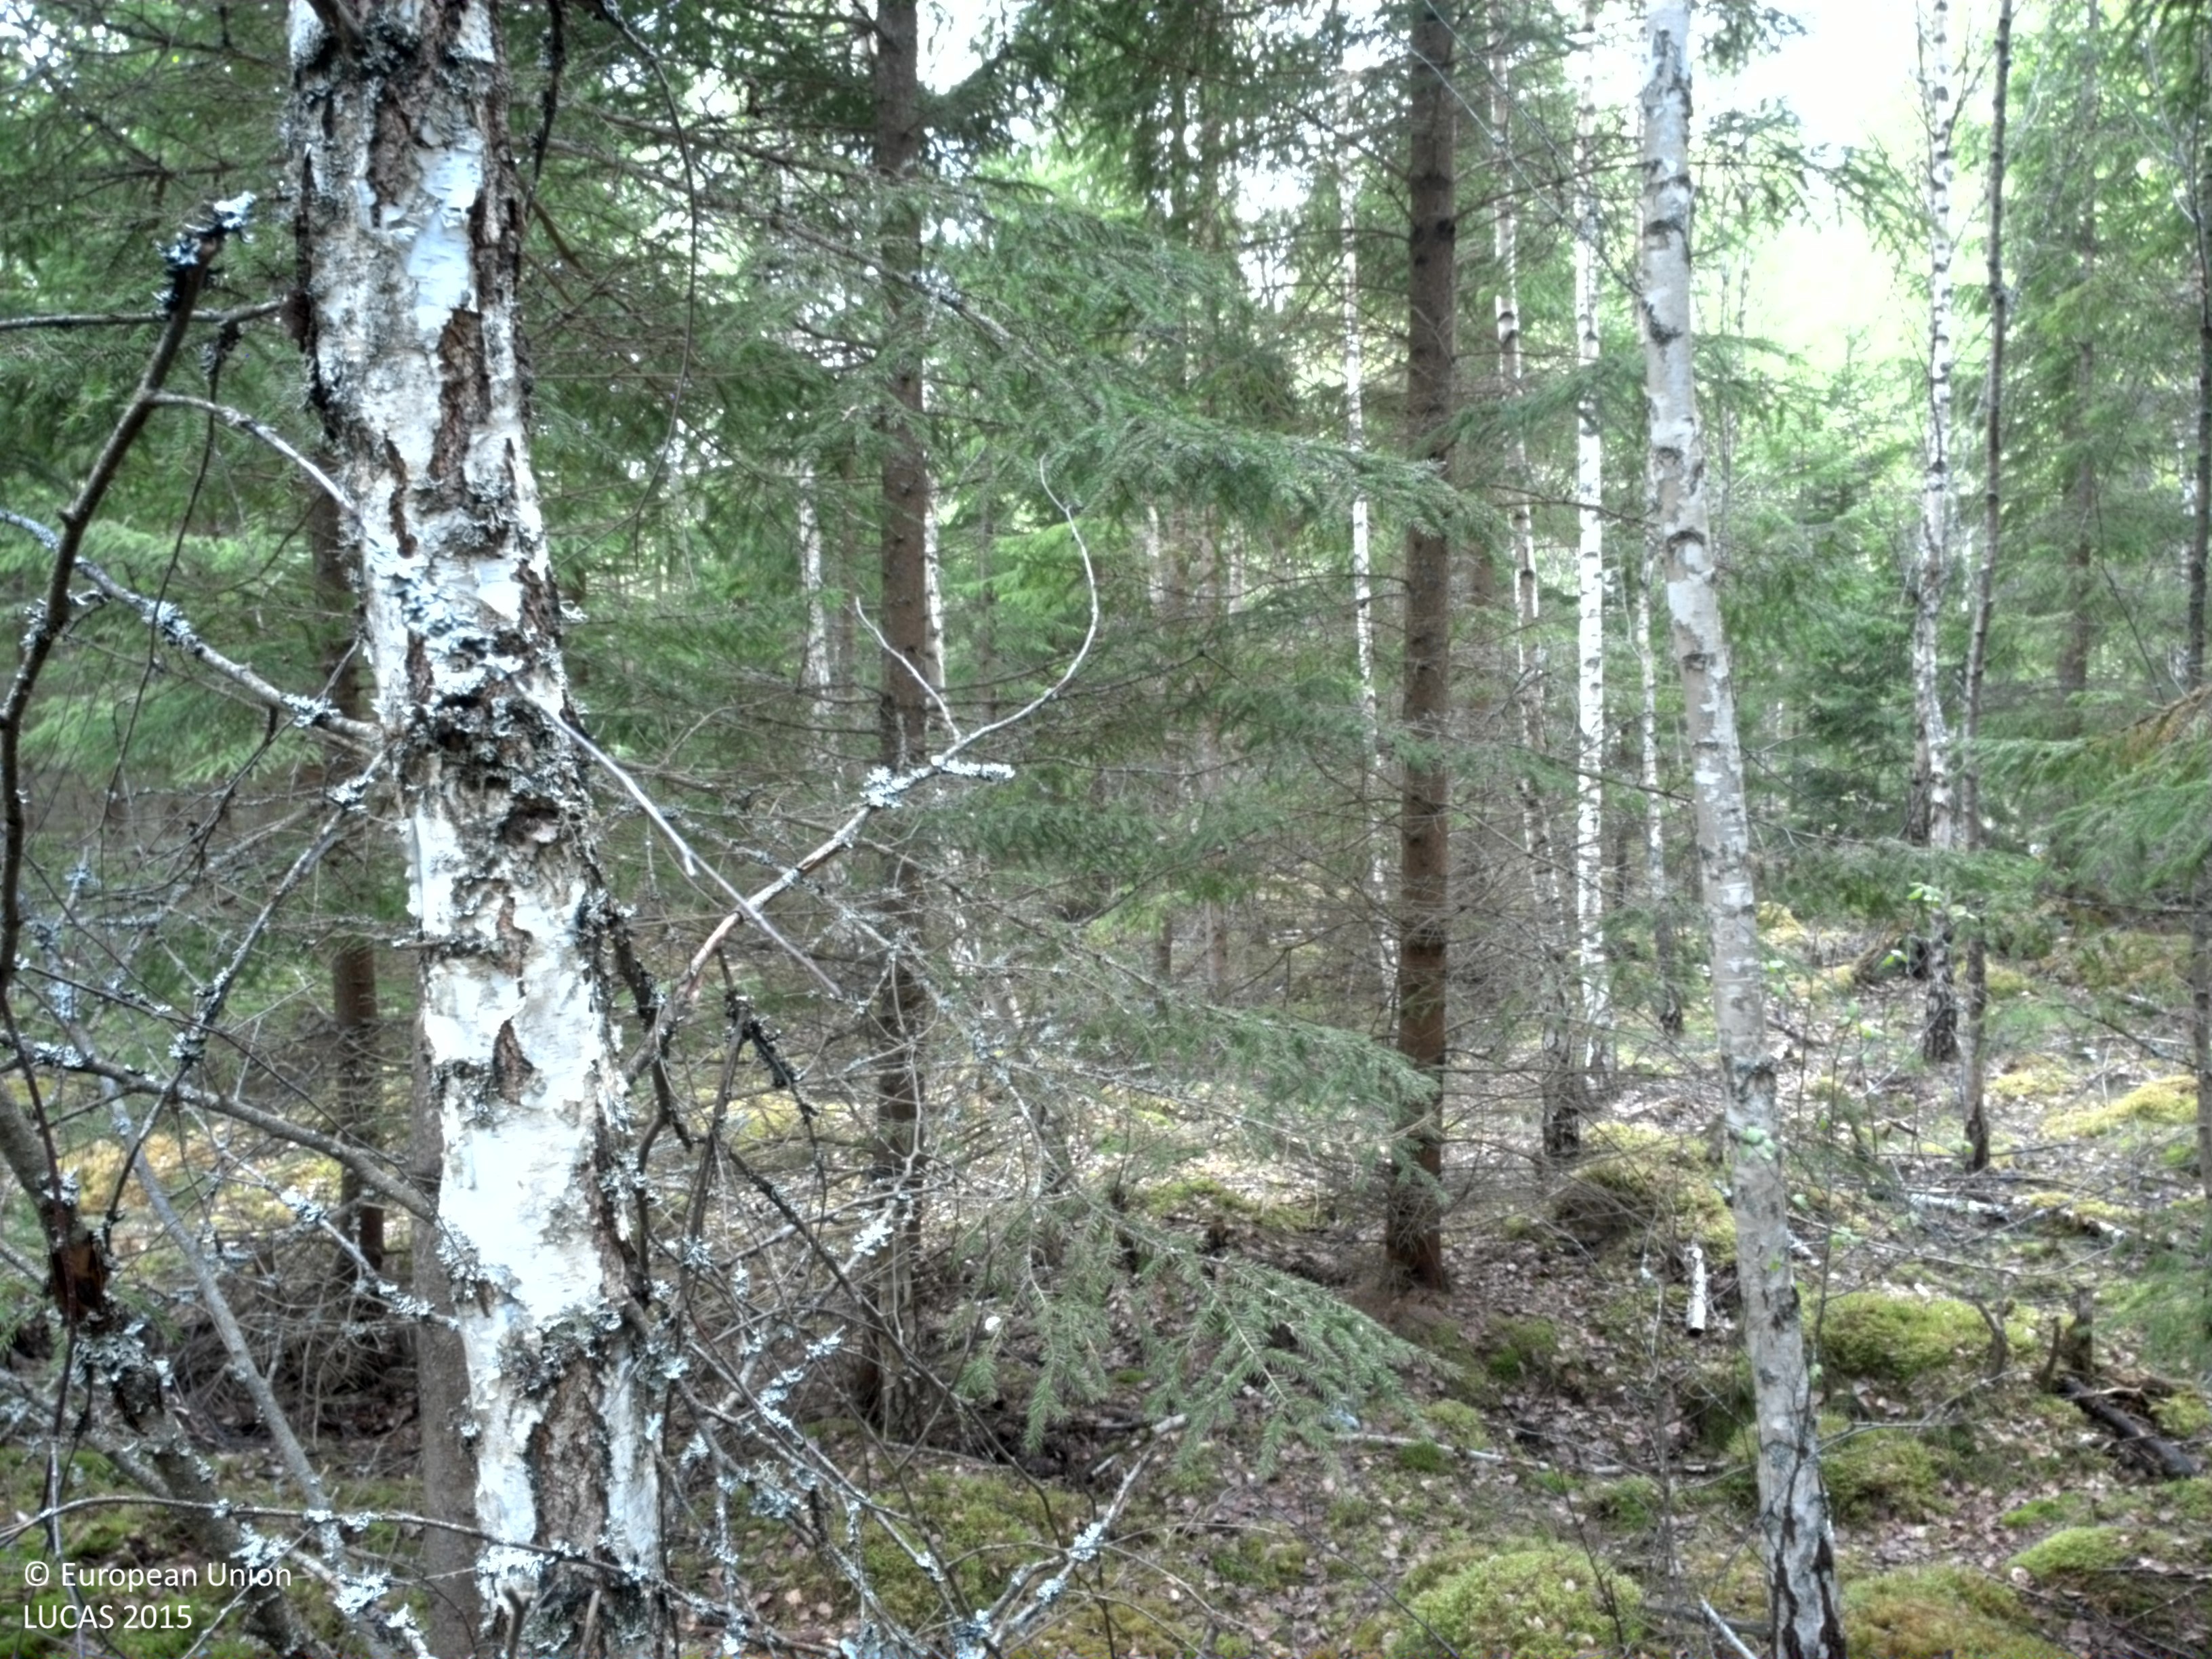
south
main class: Woodland
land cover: Spruce dominated mixed woodland
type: boreal forest
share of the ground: > 75 %
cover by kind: coniferous forest trees 40 %, broadleaved forest trees 40 %, lichens and mosses 20 %
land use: Forestry
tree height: > 5 m
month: May
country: SE
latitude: 56.7717
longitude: 15.0865
